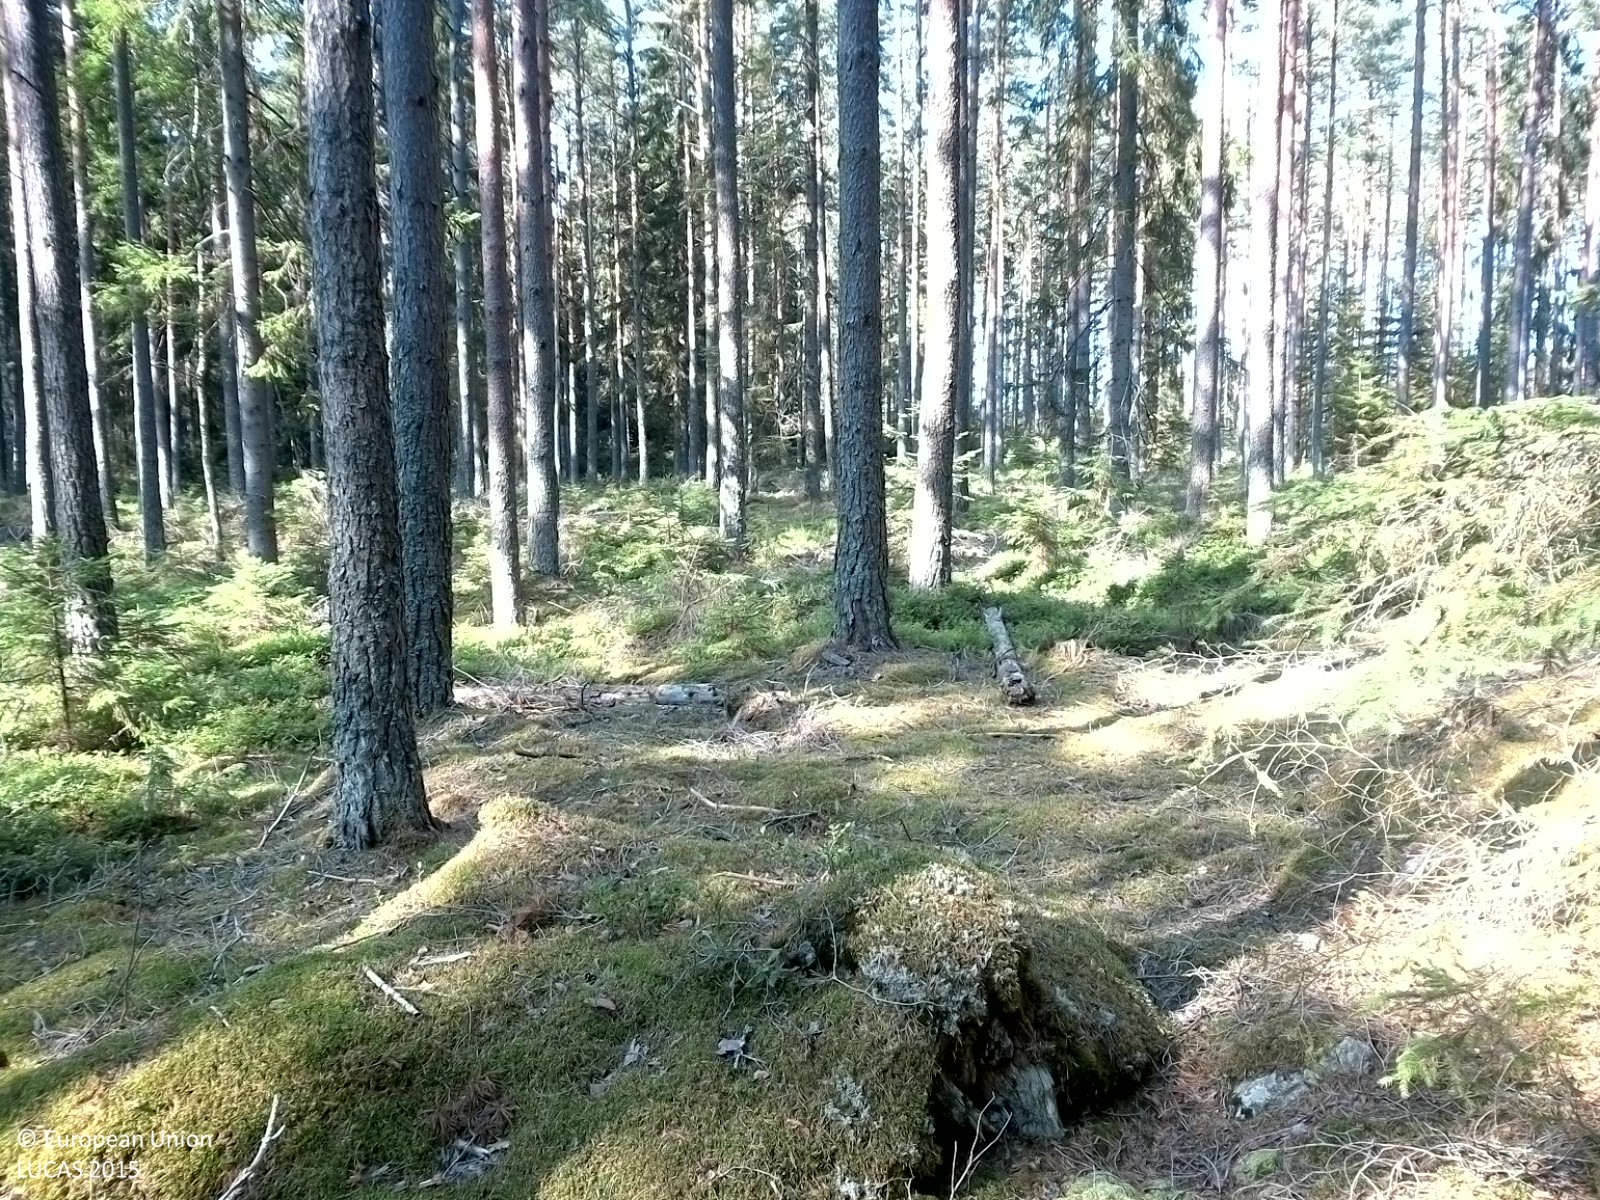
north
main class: Woodland
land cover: Pine dominated coniferous woodland
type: boreal forest
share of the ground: 25 - 50 %
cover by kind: lichens and mosses 40 %, coniferous forest trees 35 %, herbaceous plants 25 %
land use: Forestry
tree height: > 5 m
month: August
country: SE
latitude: 59.0189
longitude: 14.7470
